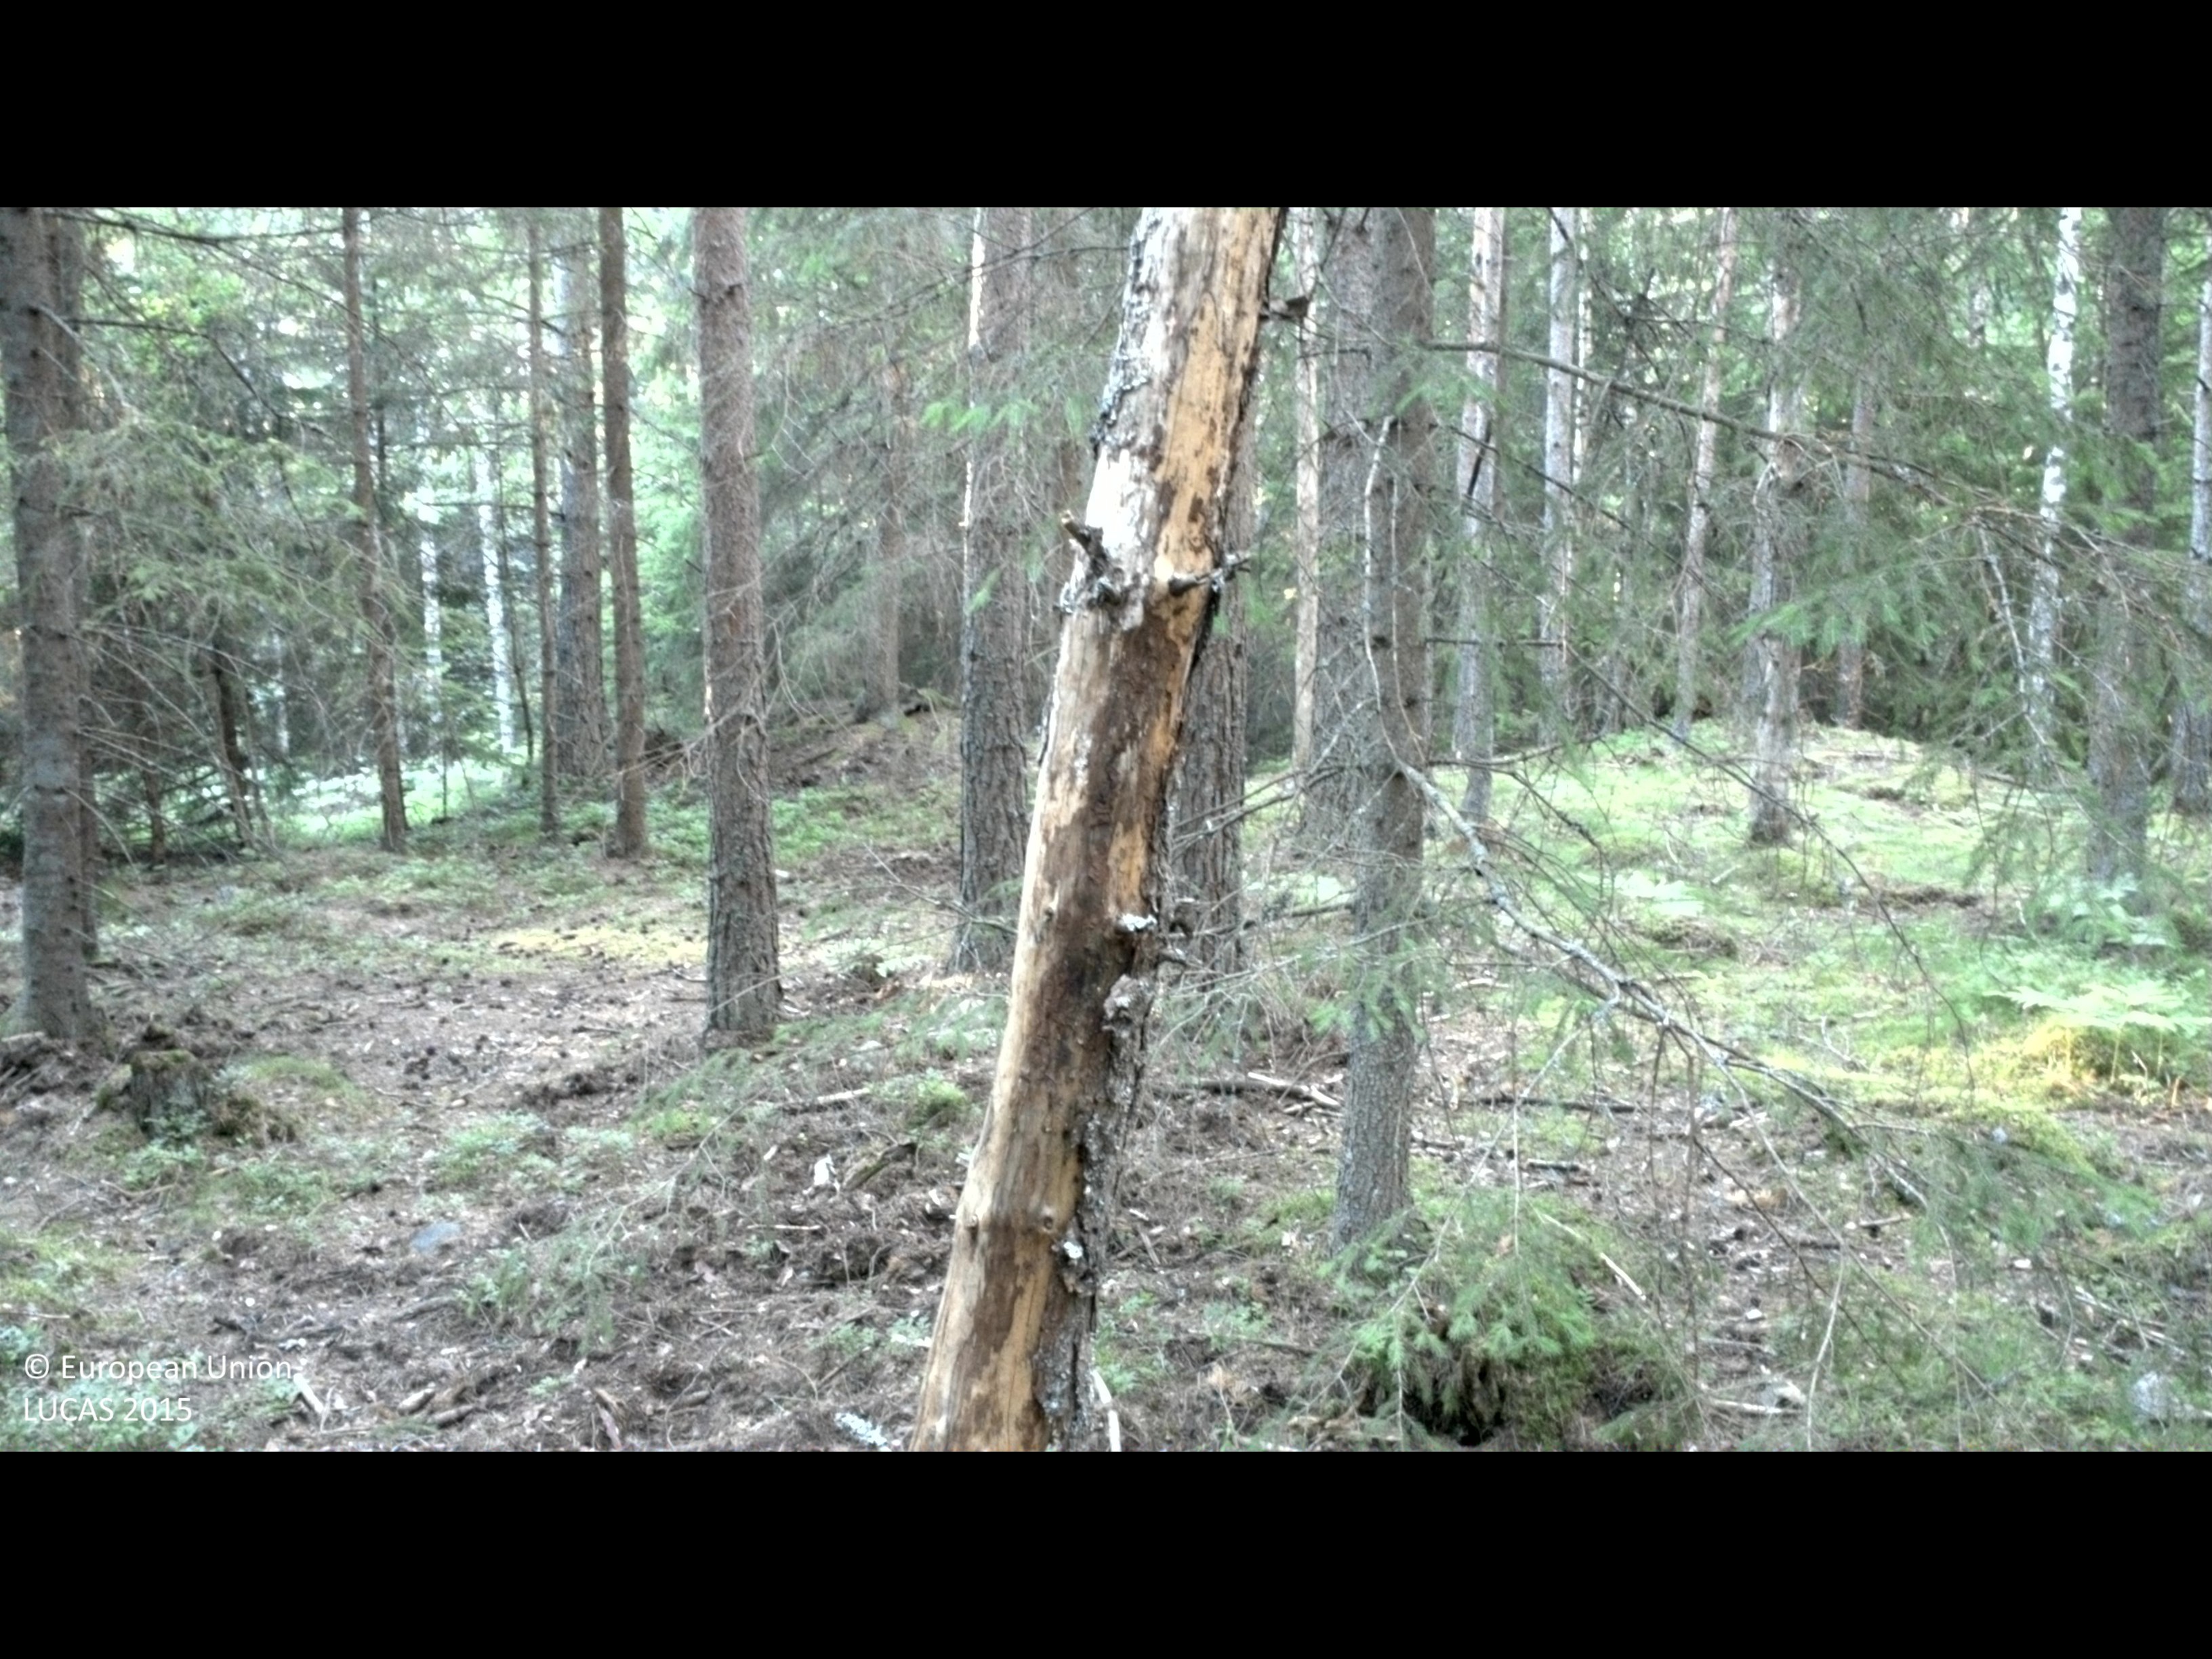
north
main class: Woodland
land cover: Other coniferous woodland
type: boreal forest
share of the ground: > 75 %
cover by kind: coniferous forest trees 65 %, broadleaved forest trees 15 %, shrubs 10 %, lichens and mosses 10 %
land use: Forestry
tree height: > 5 m
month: June
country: SE
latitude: 58.3518
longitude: 15.6849
